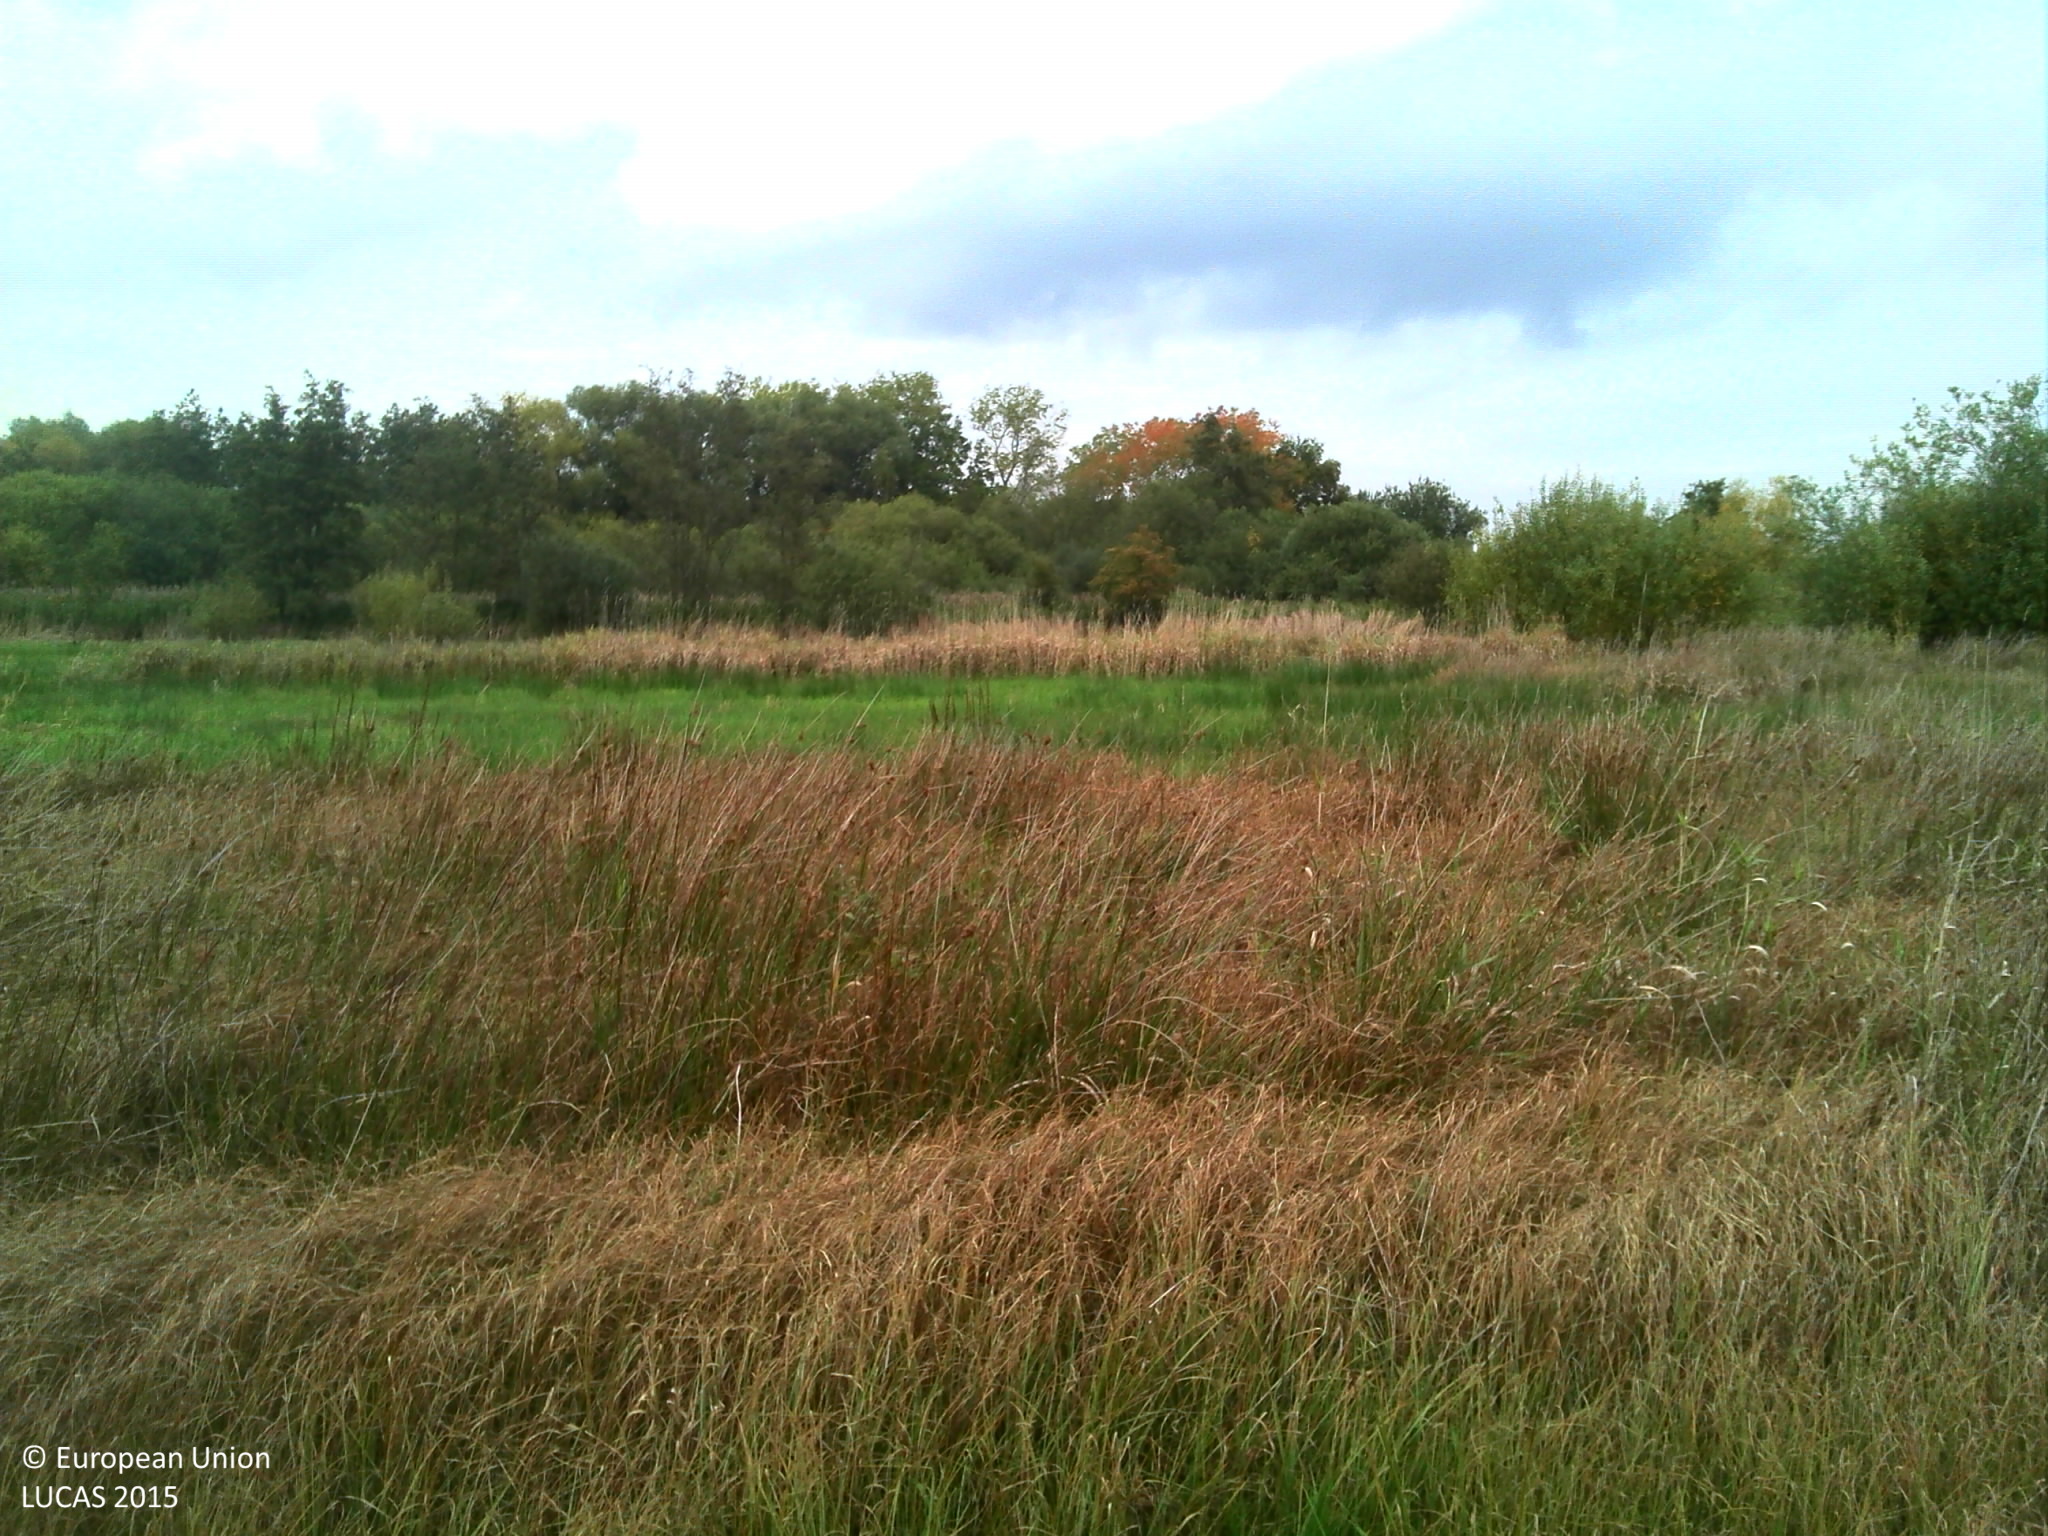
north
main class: Grassland
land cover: Grassland without tree/shrub cover
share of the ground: > 75 %
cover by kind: herbaceous plants 100 %
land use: Agriculture (excluding fallow land and kitchen gardens)
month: October
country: BE
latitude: 51.1451
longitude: 5.1803
